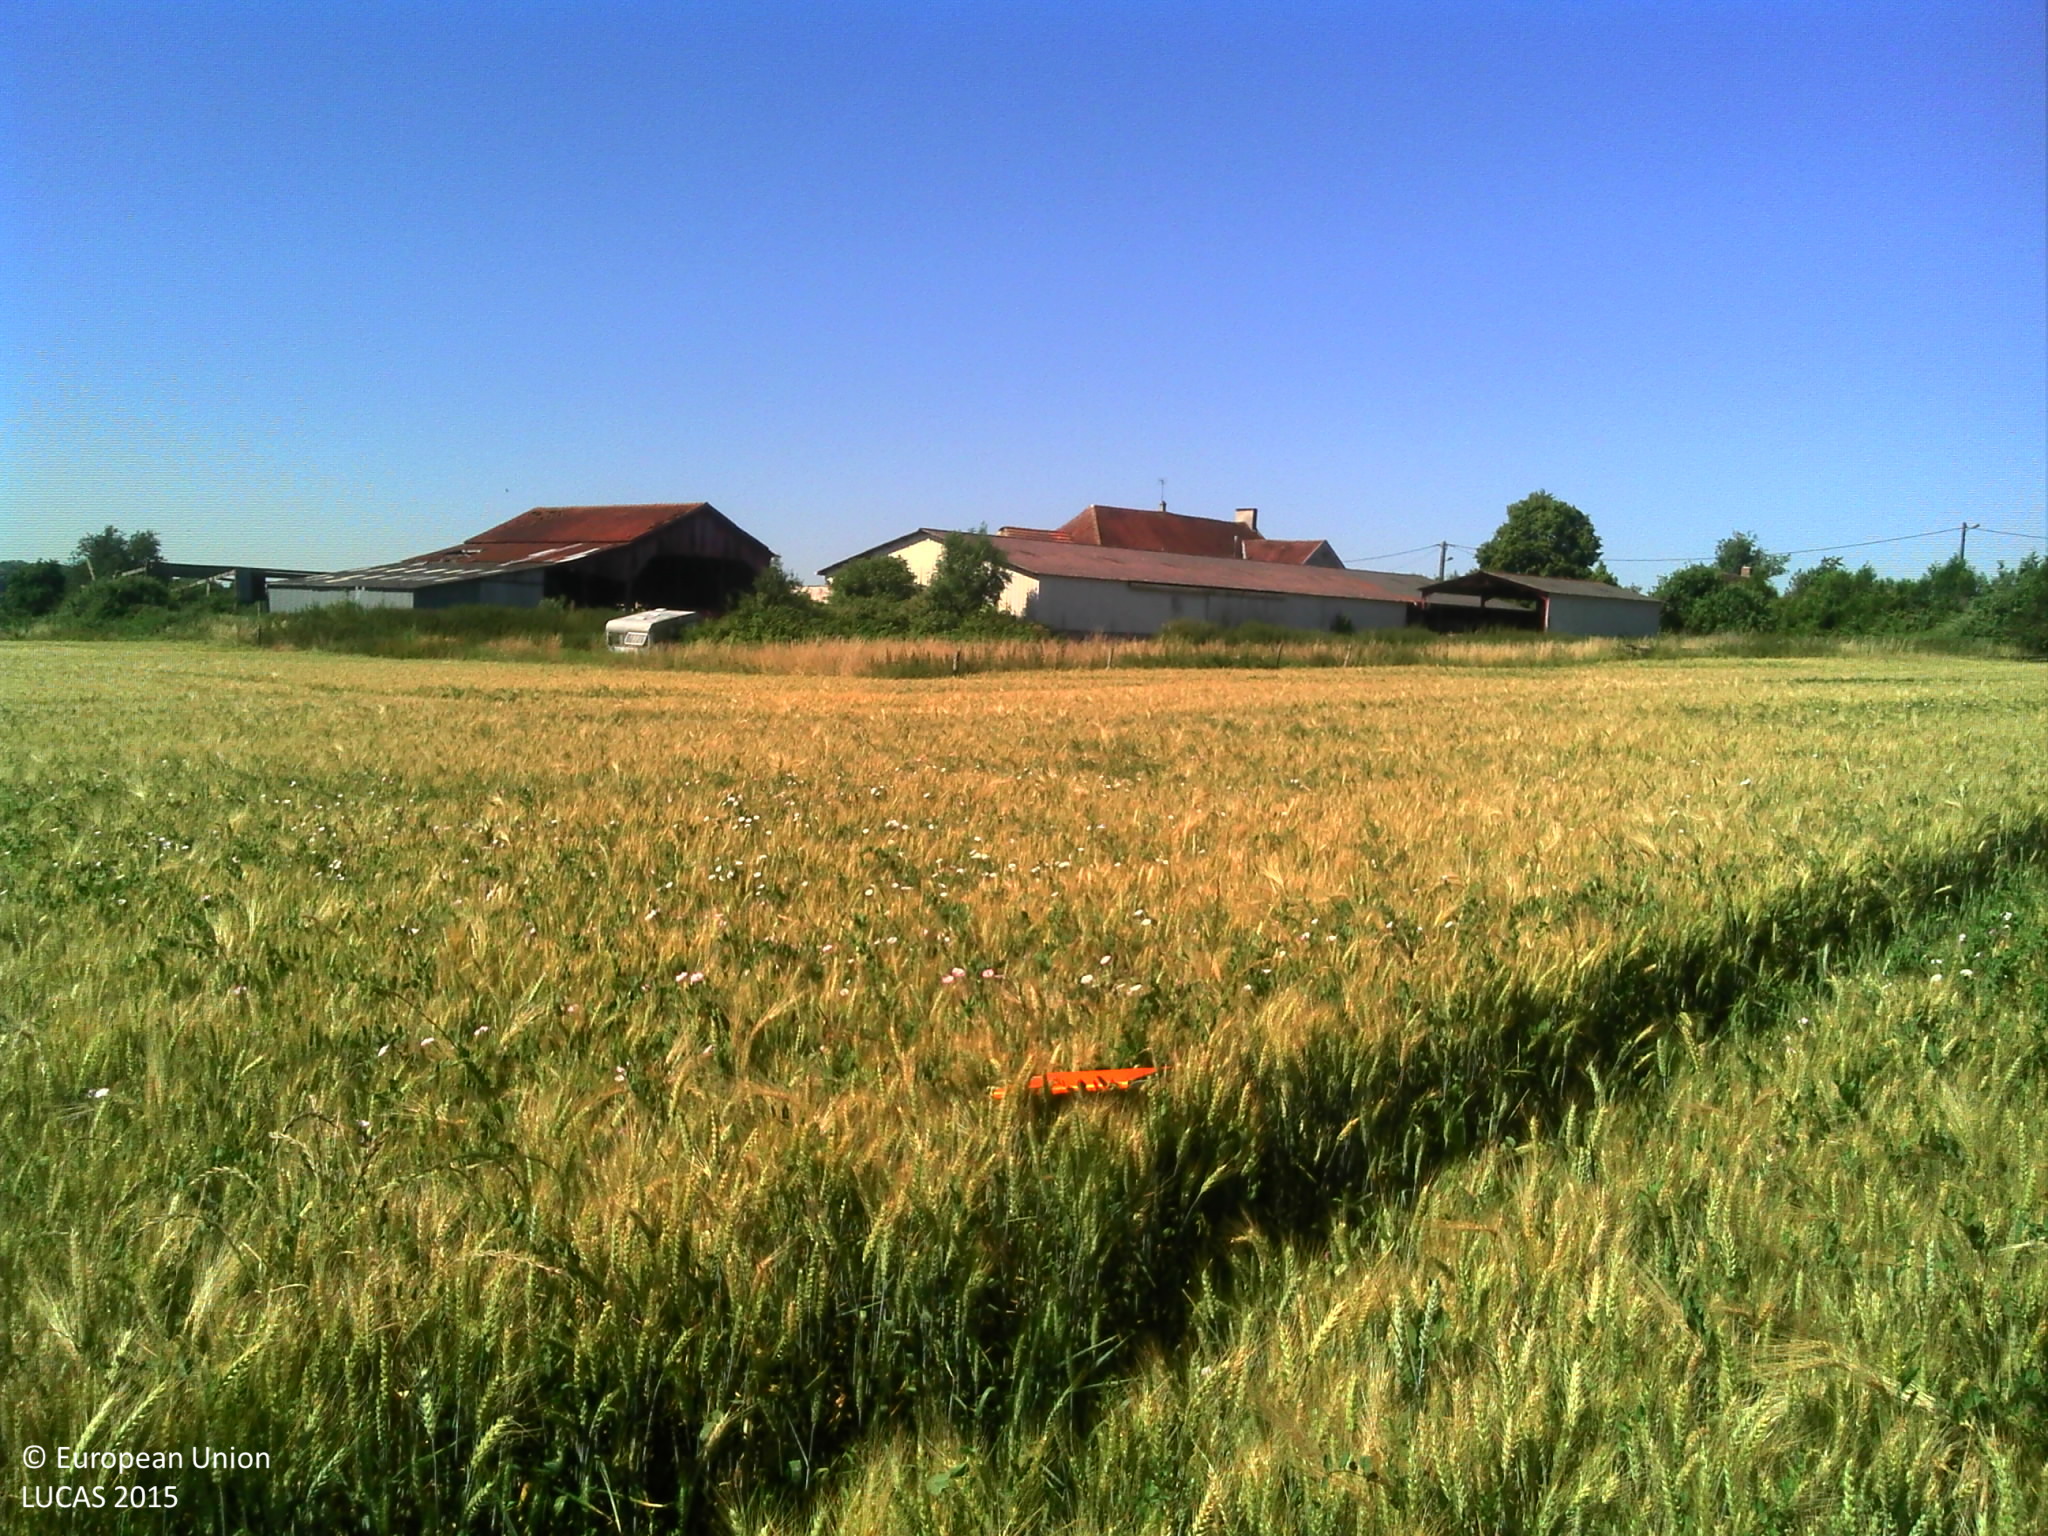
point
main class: Cropland
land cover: Common wheat
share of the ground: > 75 %
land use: Agriculture (excluding fallow land and kitchen gardens)
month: June
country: FR
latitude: 48.8746
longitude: 3.4076
